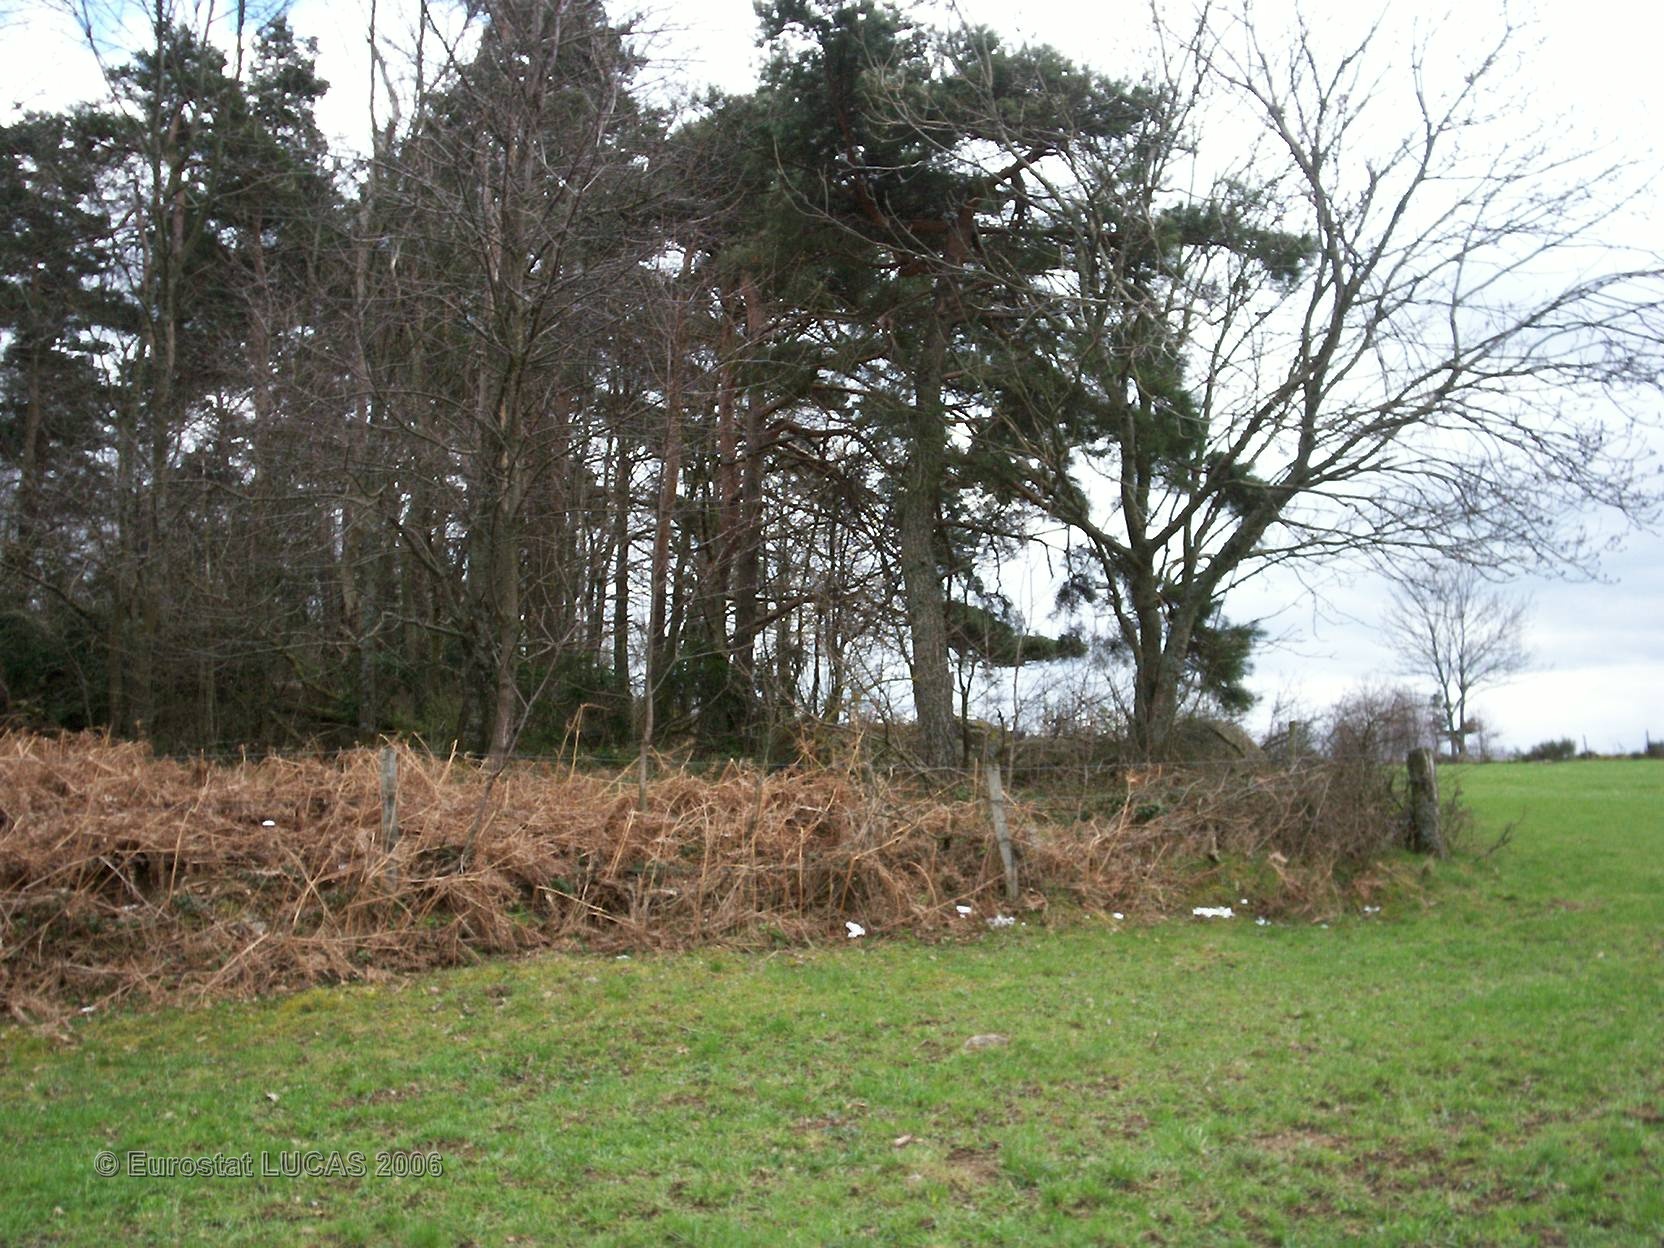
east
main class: Grassland
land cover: Grassland with sparse tree/shrub cover
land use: Agriculture (excluding fallow land and kitchen gardens)
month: April
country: FR
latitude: 45.3973
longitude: 4.1656
